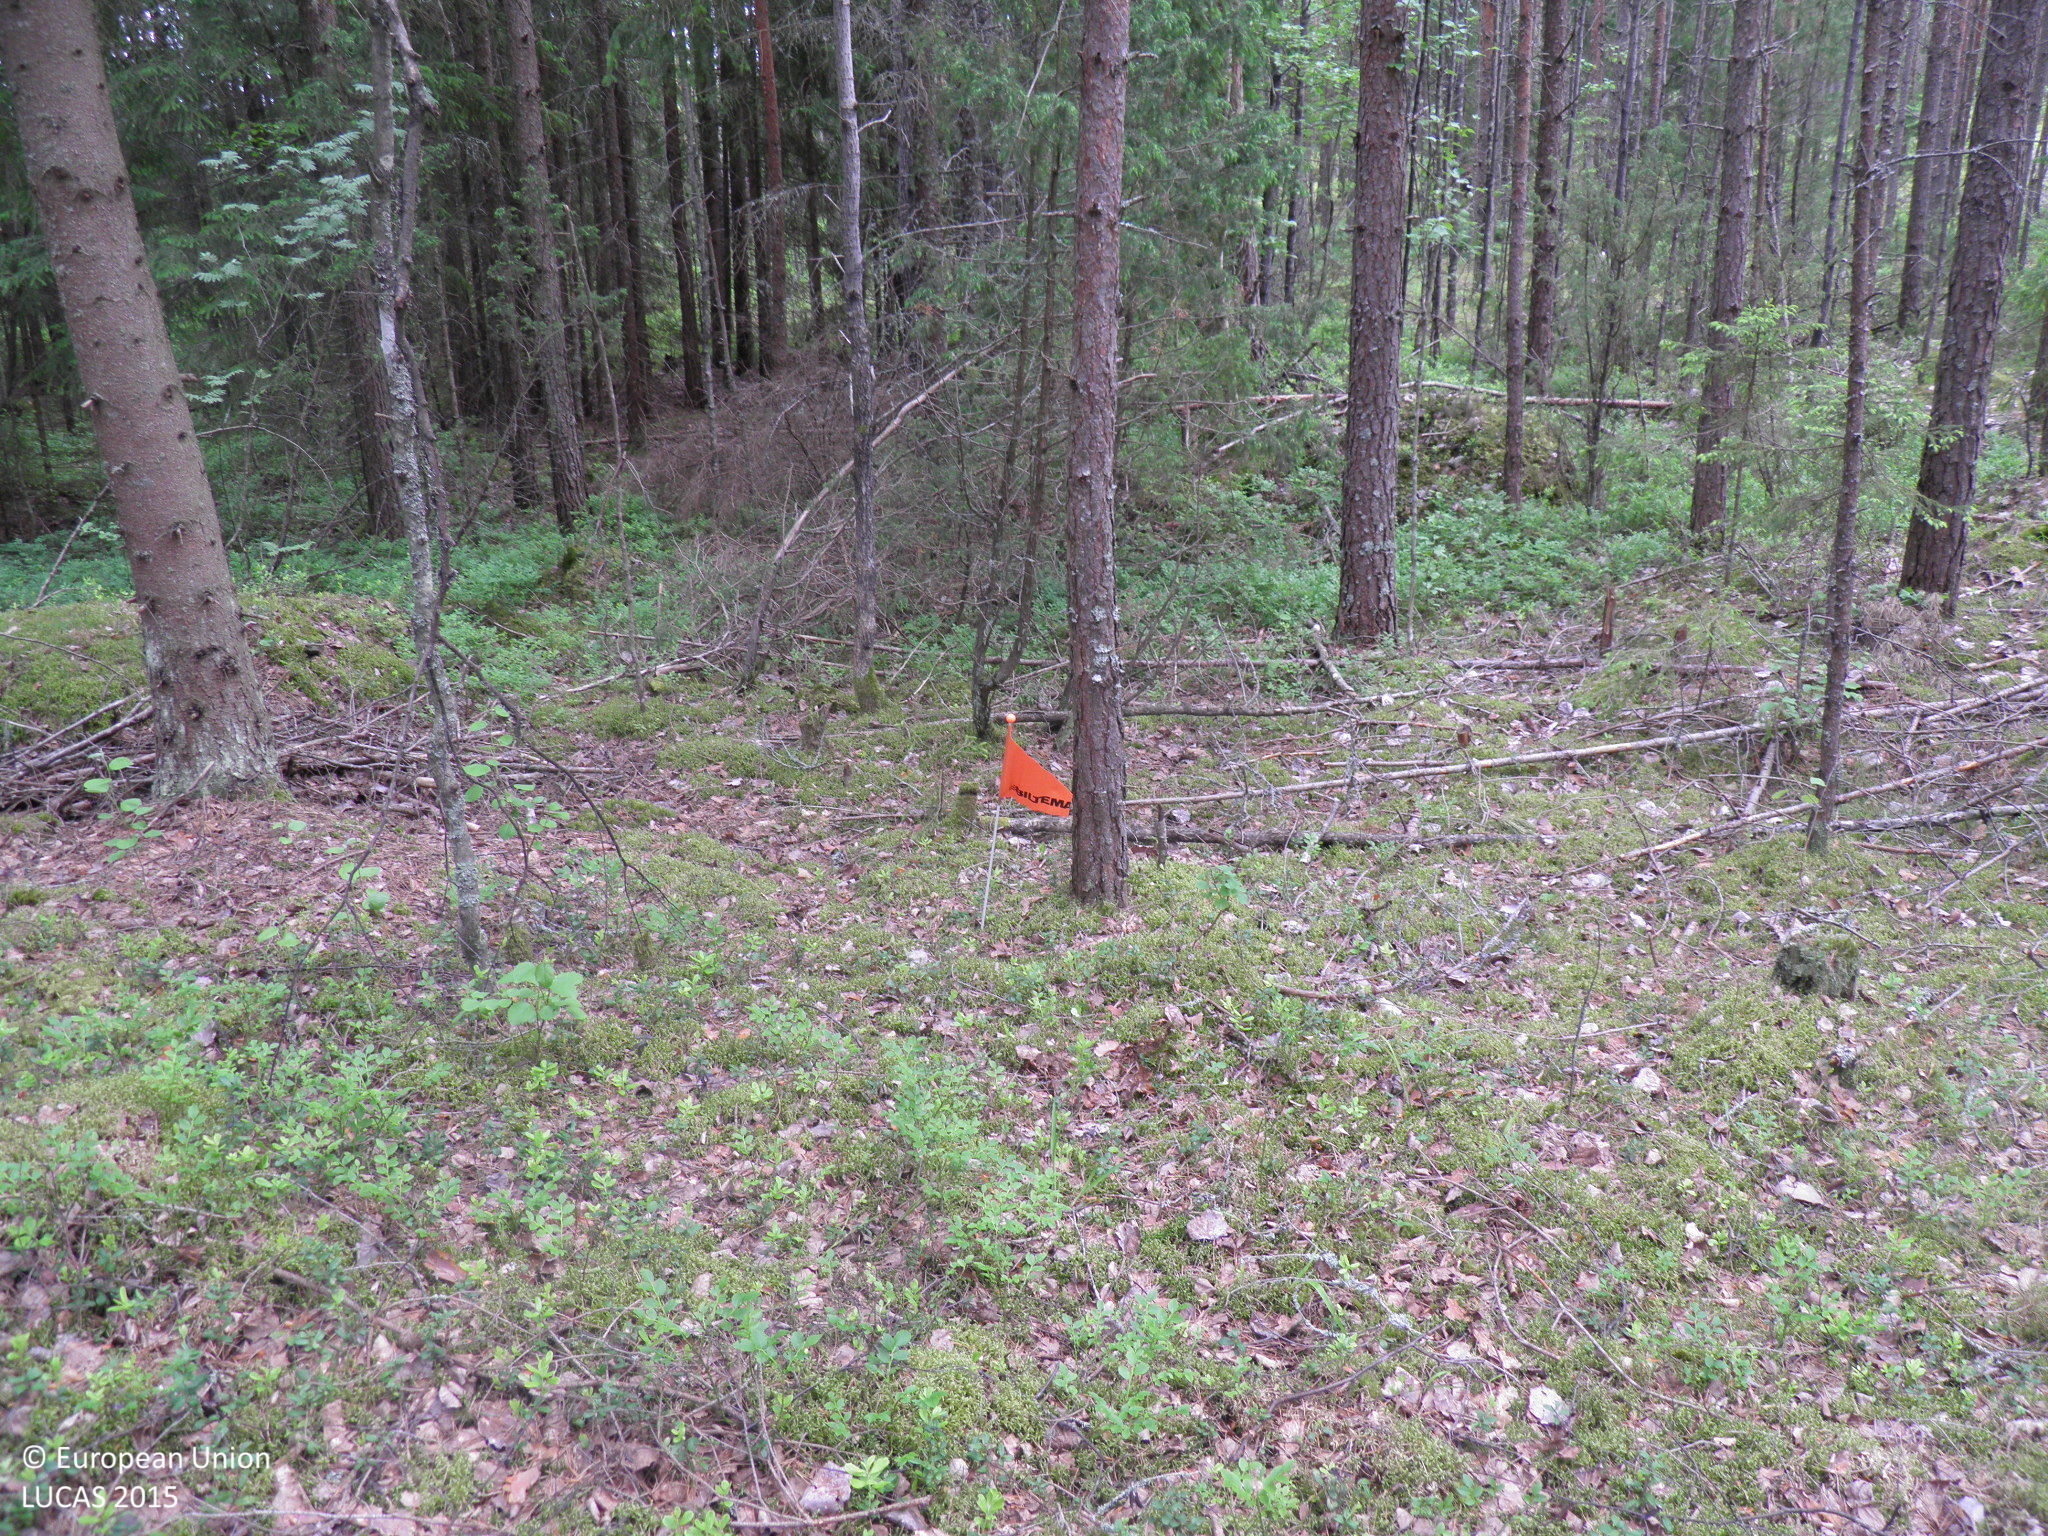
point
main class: Woodland
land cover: Pine dominated coniferous woodland
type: boreal forest
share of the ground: > 75 %
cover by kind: coniferous forest trees 80 %, lichens and mosses 10 %, broadleaved forest trees 5 %, shrubs 5 %
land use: Forestry
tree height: > 5 m
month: June
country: FI
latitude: 60.2751
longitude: 22.7499
